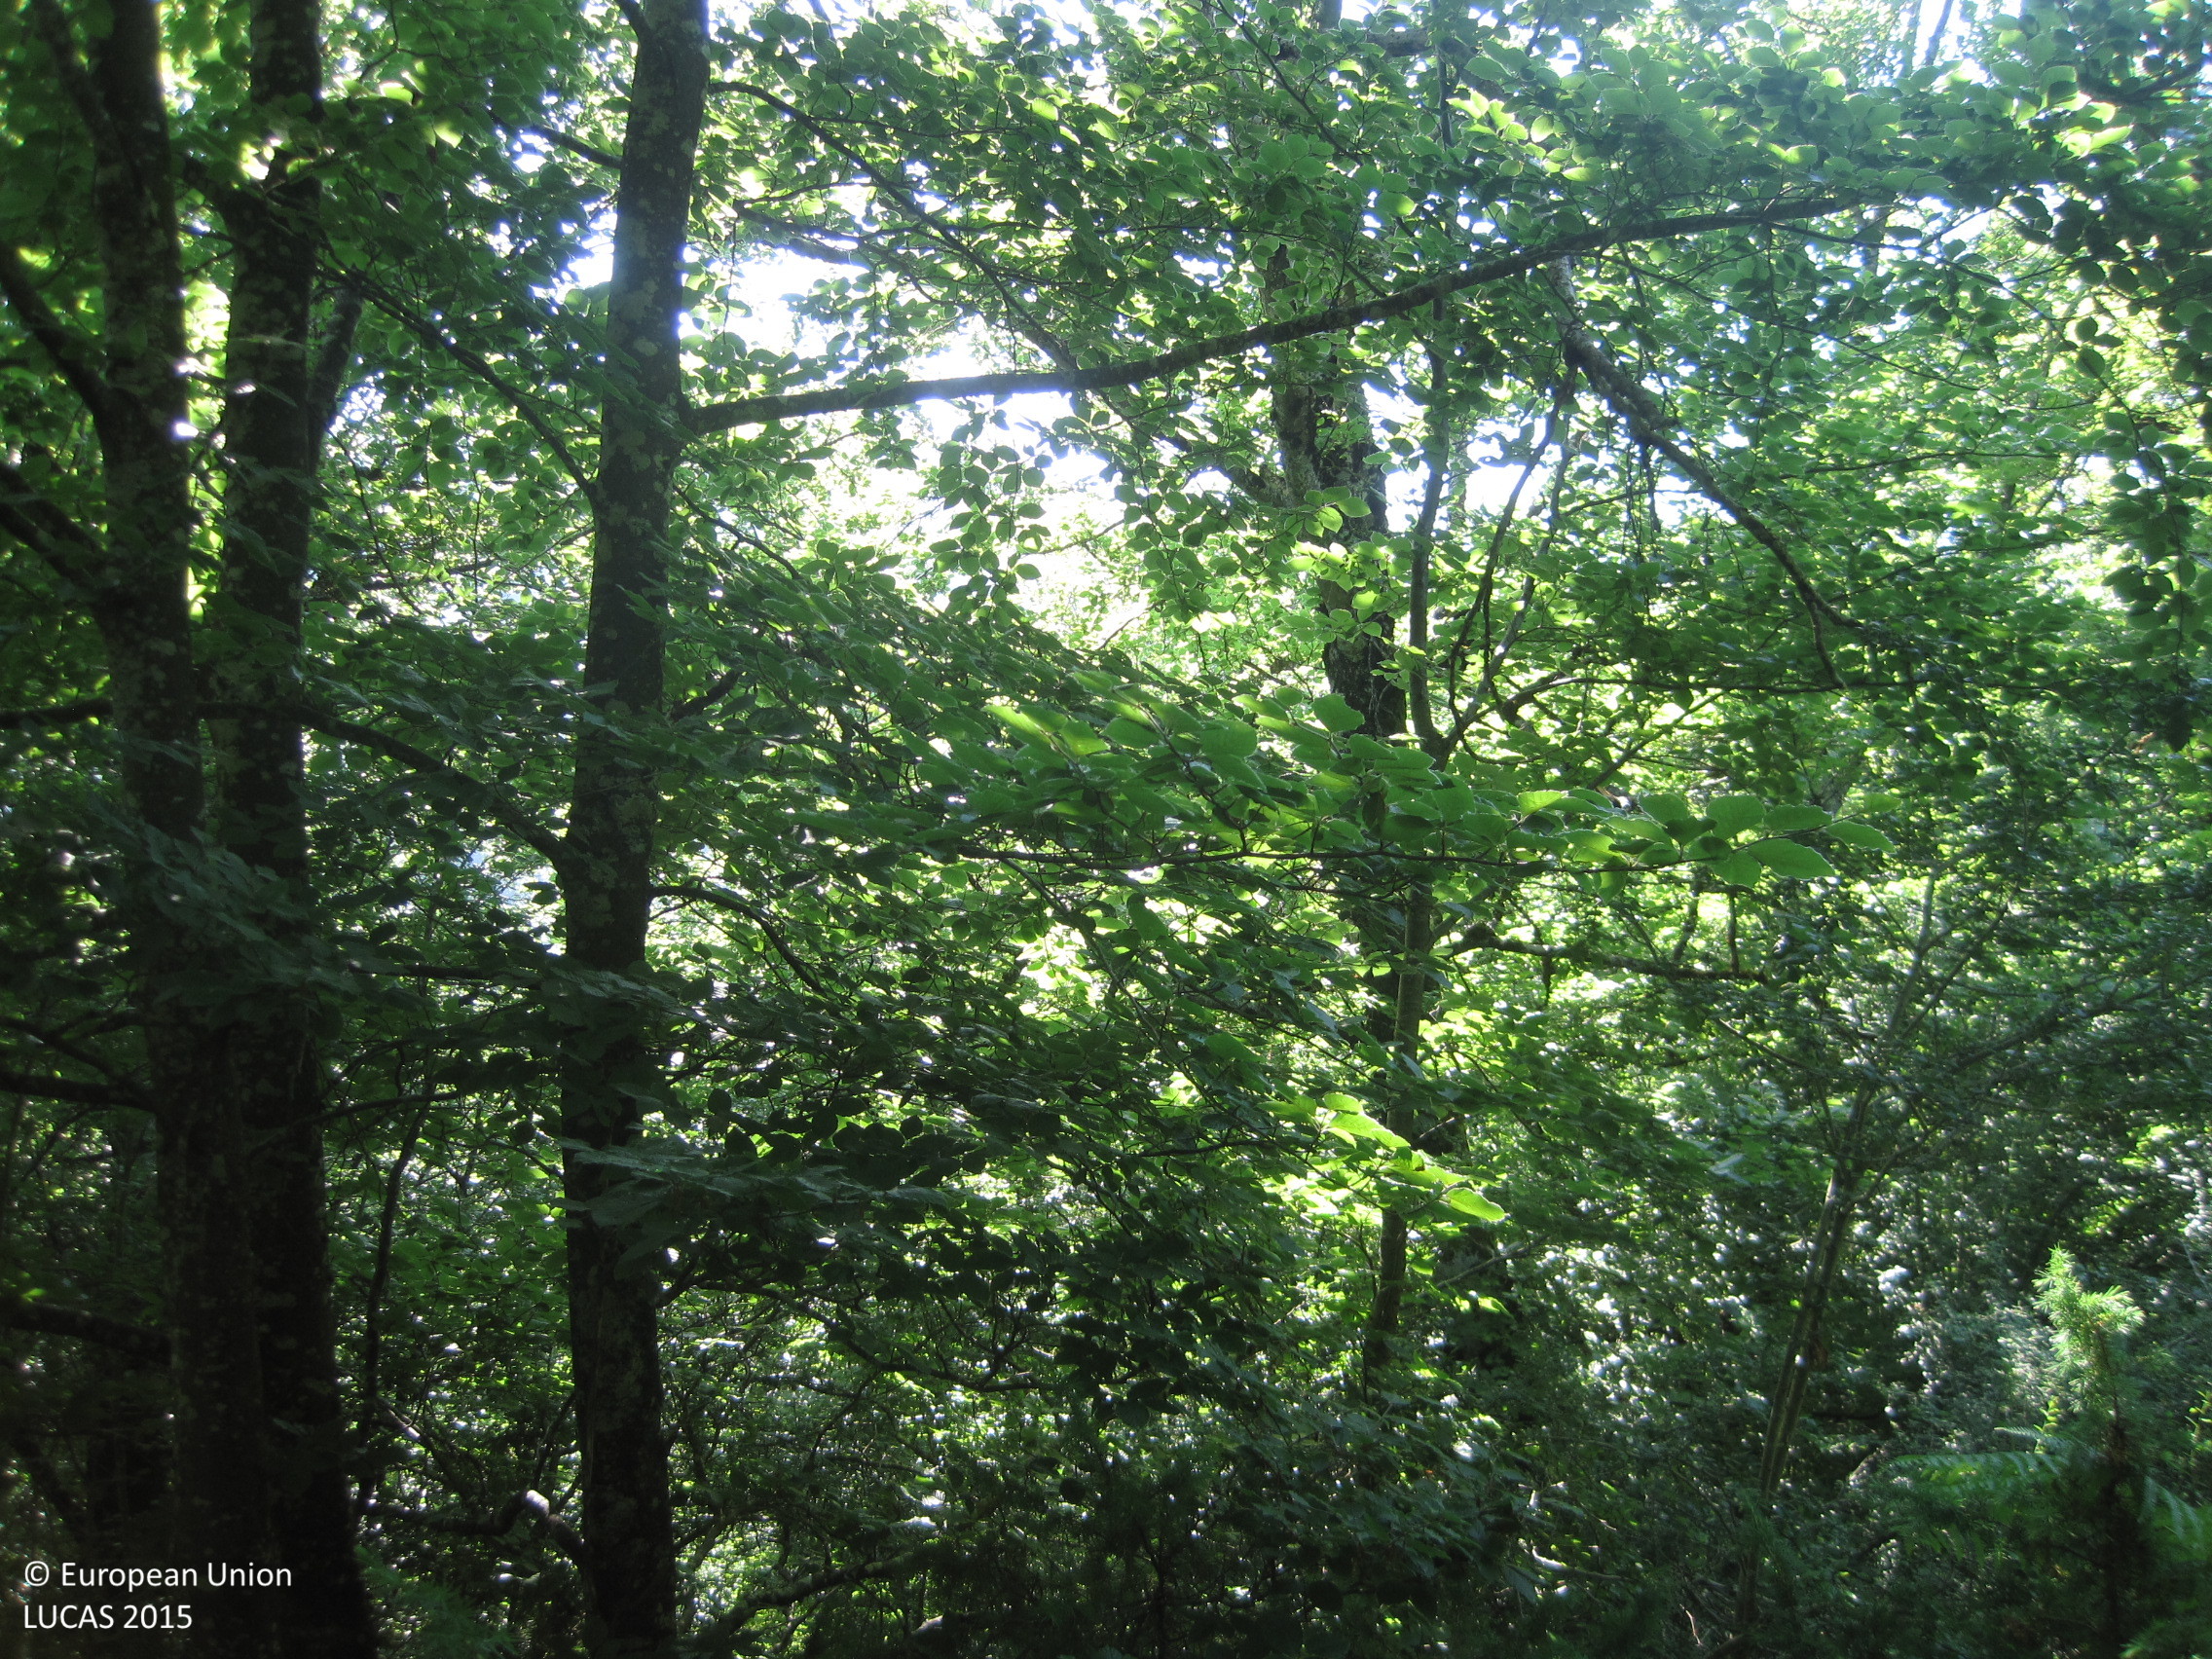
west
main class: Woodland
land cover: Broadleaved woodland
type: beech forest
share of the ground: > 75 %
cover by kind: broadleaved forest trees 100 %
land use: Forestry
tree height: > 5 m
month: June
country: ES
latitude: 42.9288
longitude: -1.7919
